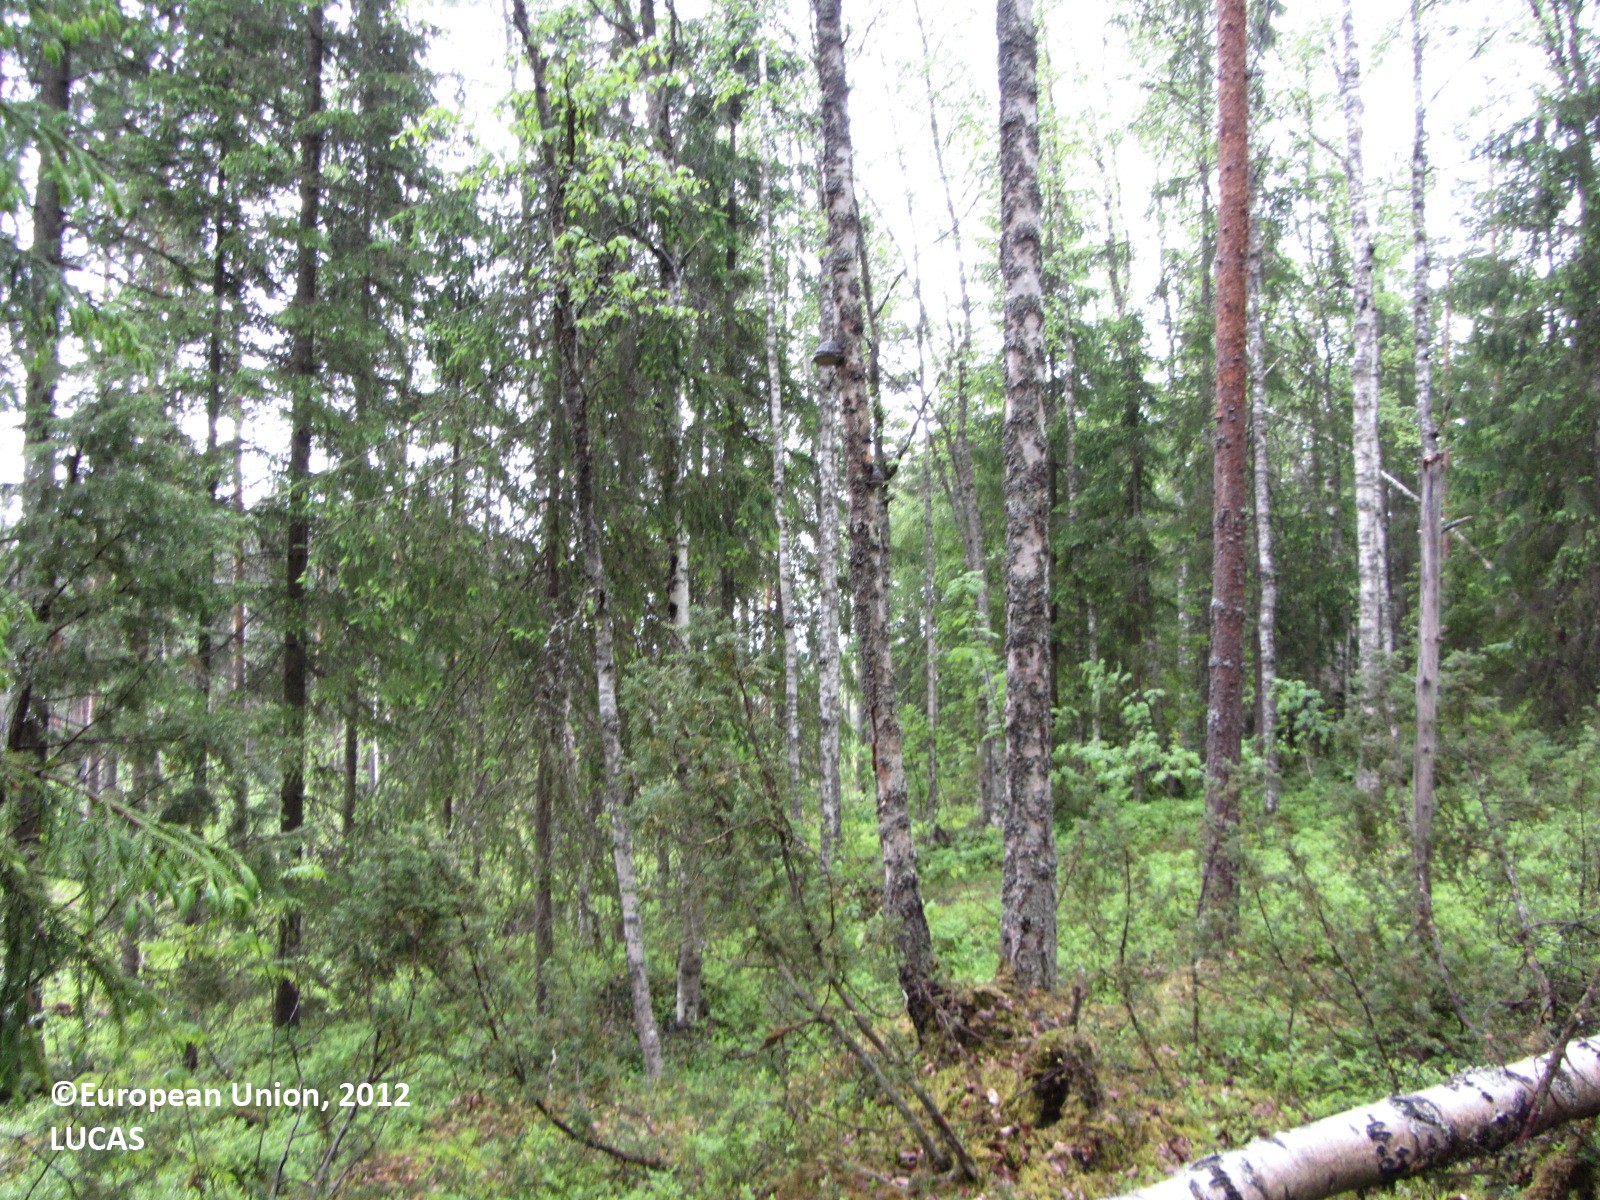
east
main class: Woodland
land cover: Spruce dominated mixed woodland
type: boreal forest
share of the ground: 50 - 75 %
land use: Forestry
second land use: Sport
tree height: > 5 m
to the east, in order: Spruce dominated mixed woodland; Tracks; Pine dominated mixed woodland; Tracks; Abandoned hedges; Pine dominated mixed woodland; Tracks; Pine dominated coniferous woodland; Tracks; Pine dominated coniferous woodland; Tracks; Pine dominated coniferous woodland; Pine dominated mixed woodland; Pine dominated coniferous woodland
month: June
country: FI
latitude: 61.8972
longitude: 25.1231
